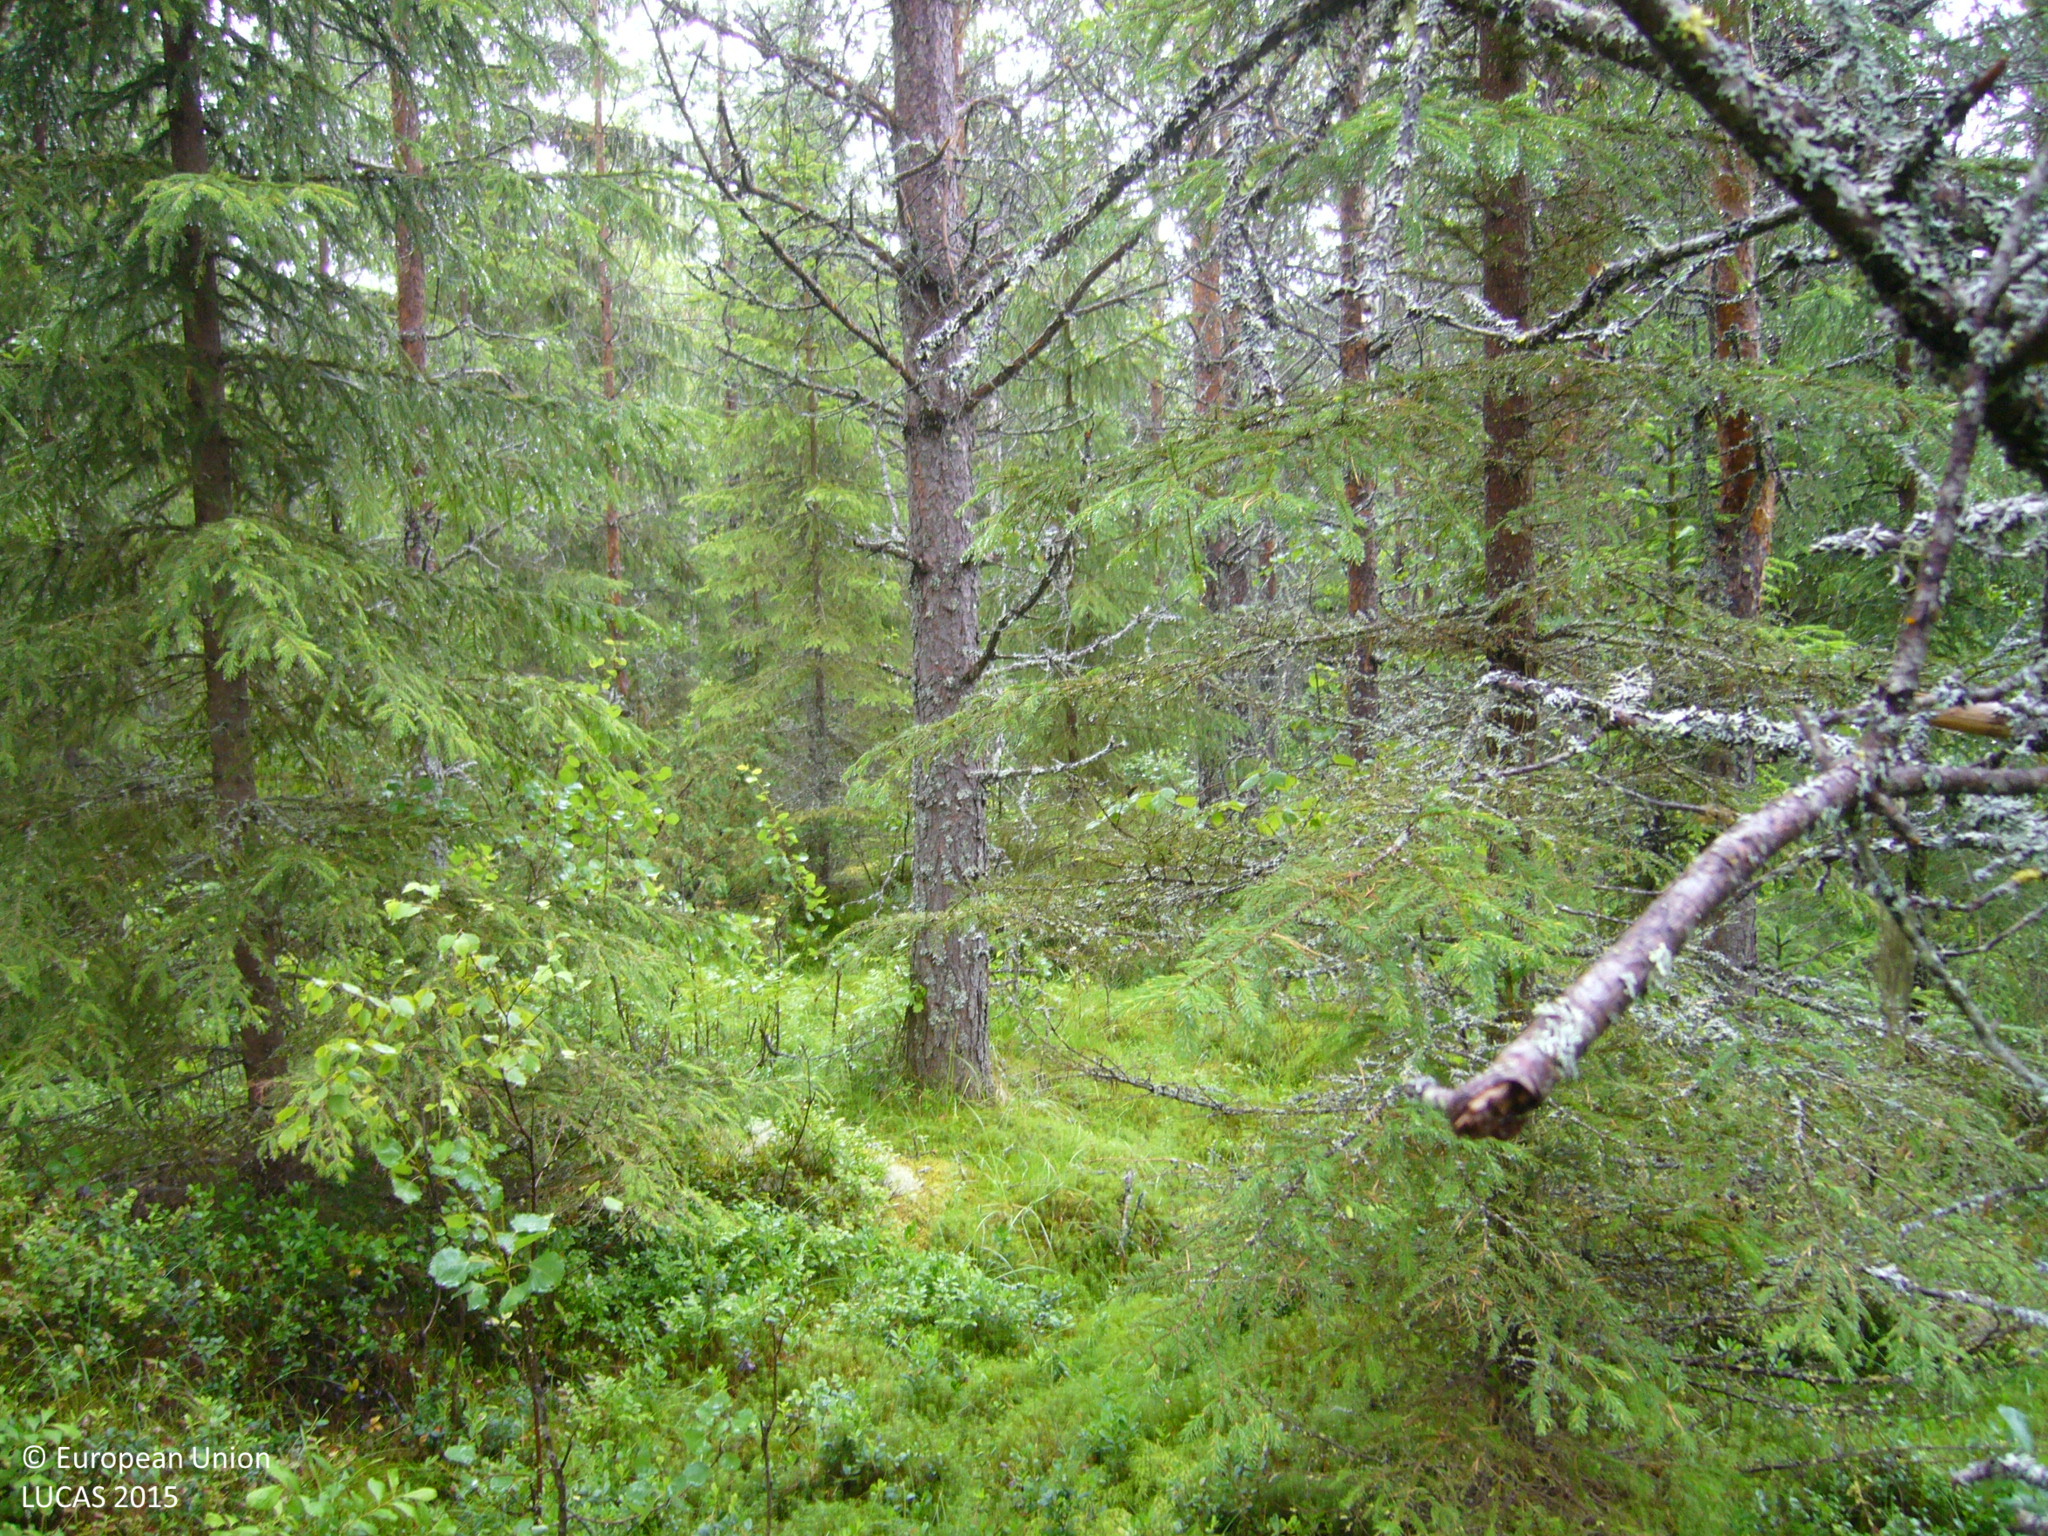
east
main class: Woodland
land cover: Pine dominated mixed woodland
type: boreal forest
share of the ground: > 75 %
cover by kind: coniferous forest trees 50 %, broadleaved forest trees 25 %, shrubs 25 %
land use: Forestry
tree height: > 5 m
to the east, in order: Pine dominated mixed woodland; Tracks; Pine dominated mixed woodland; Ditches and canals; Pine dominated coniferous woodland; Pine dominated mixed woodland
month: July
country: FI
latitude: 63.8523
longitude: 26.0355
